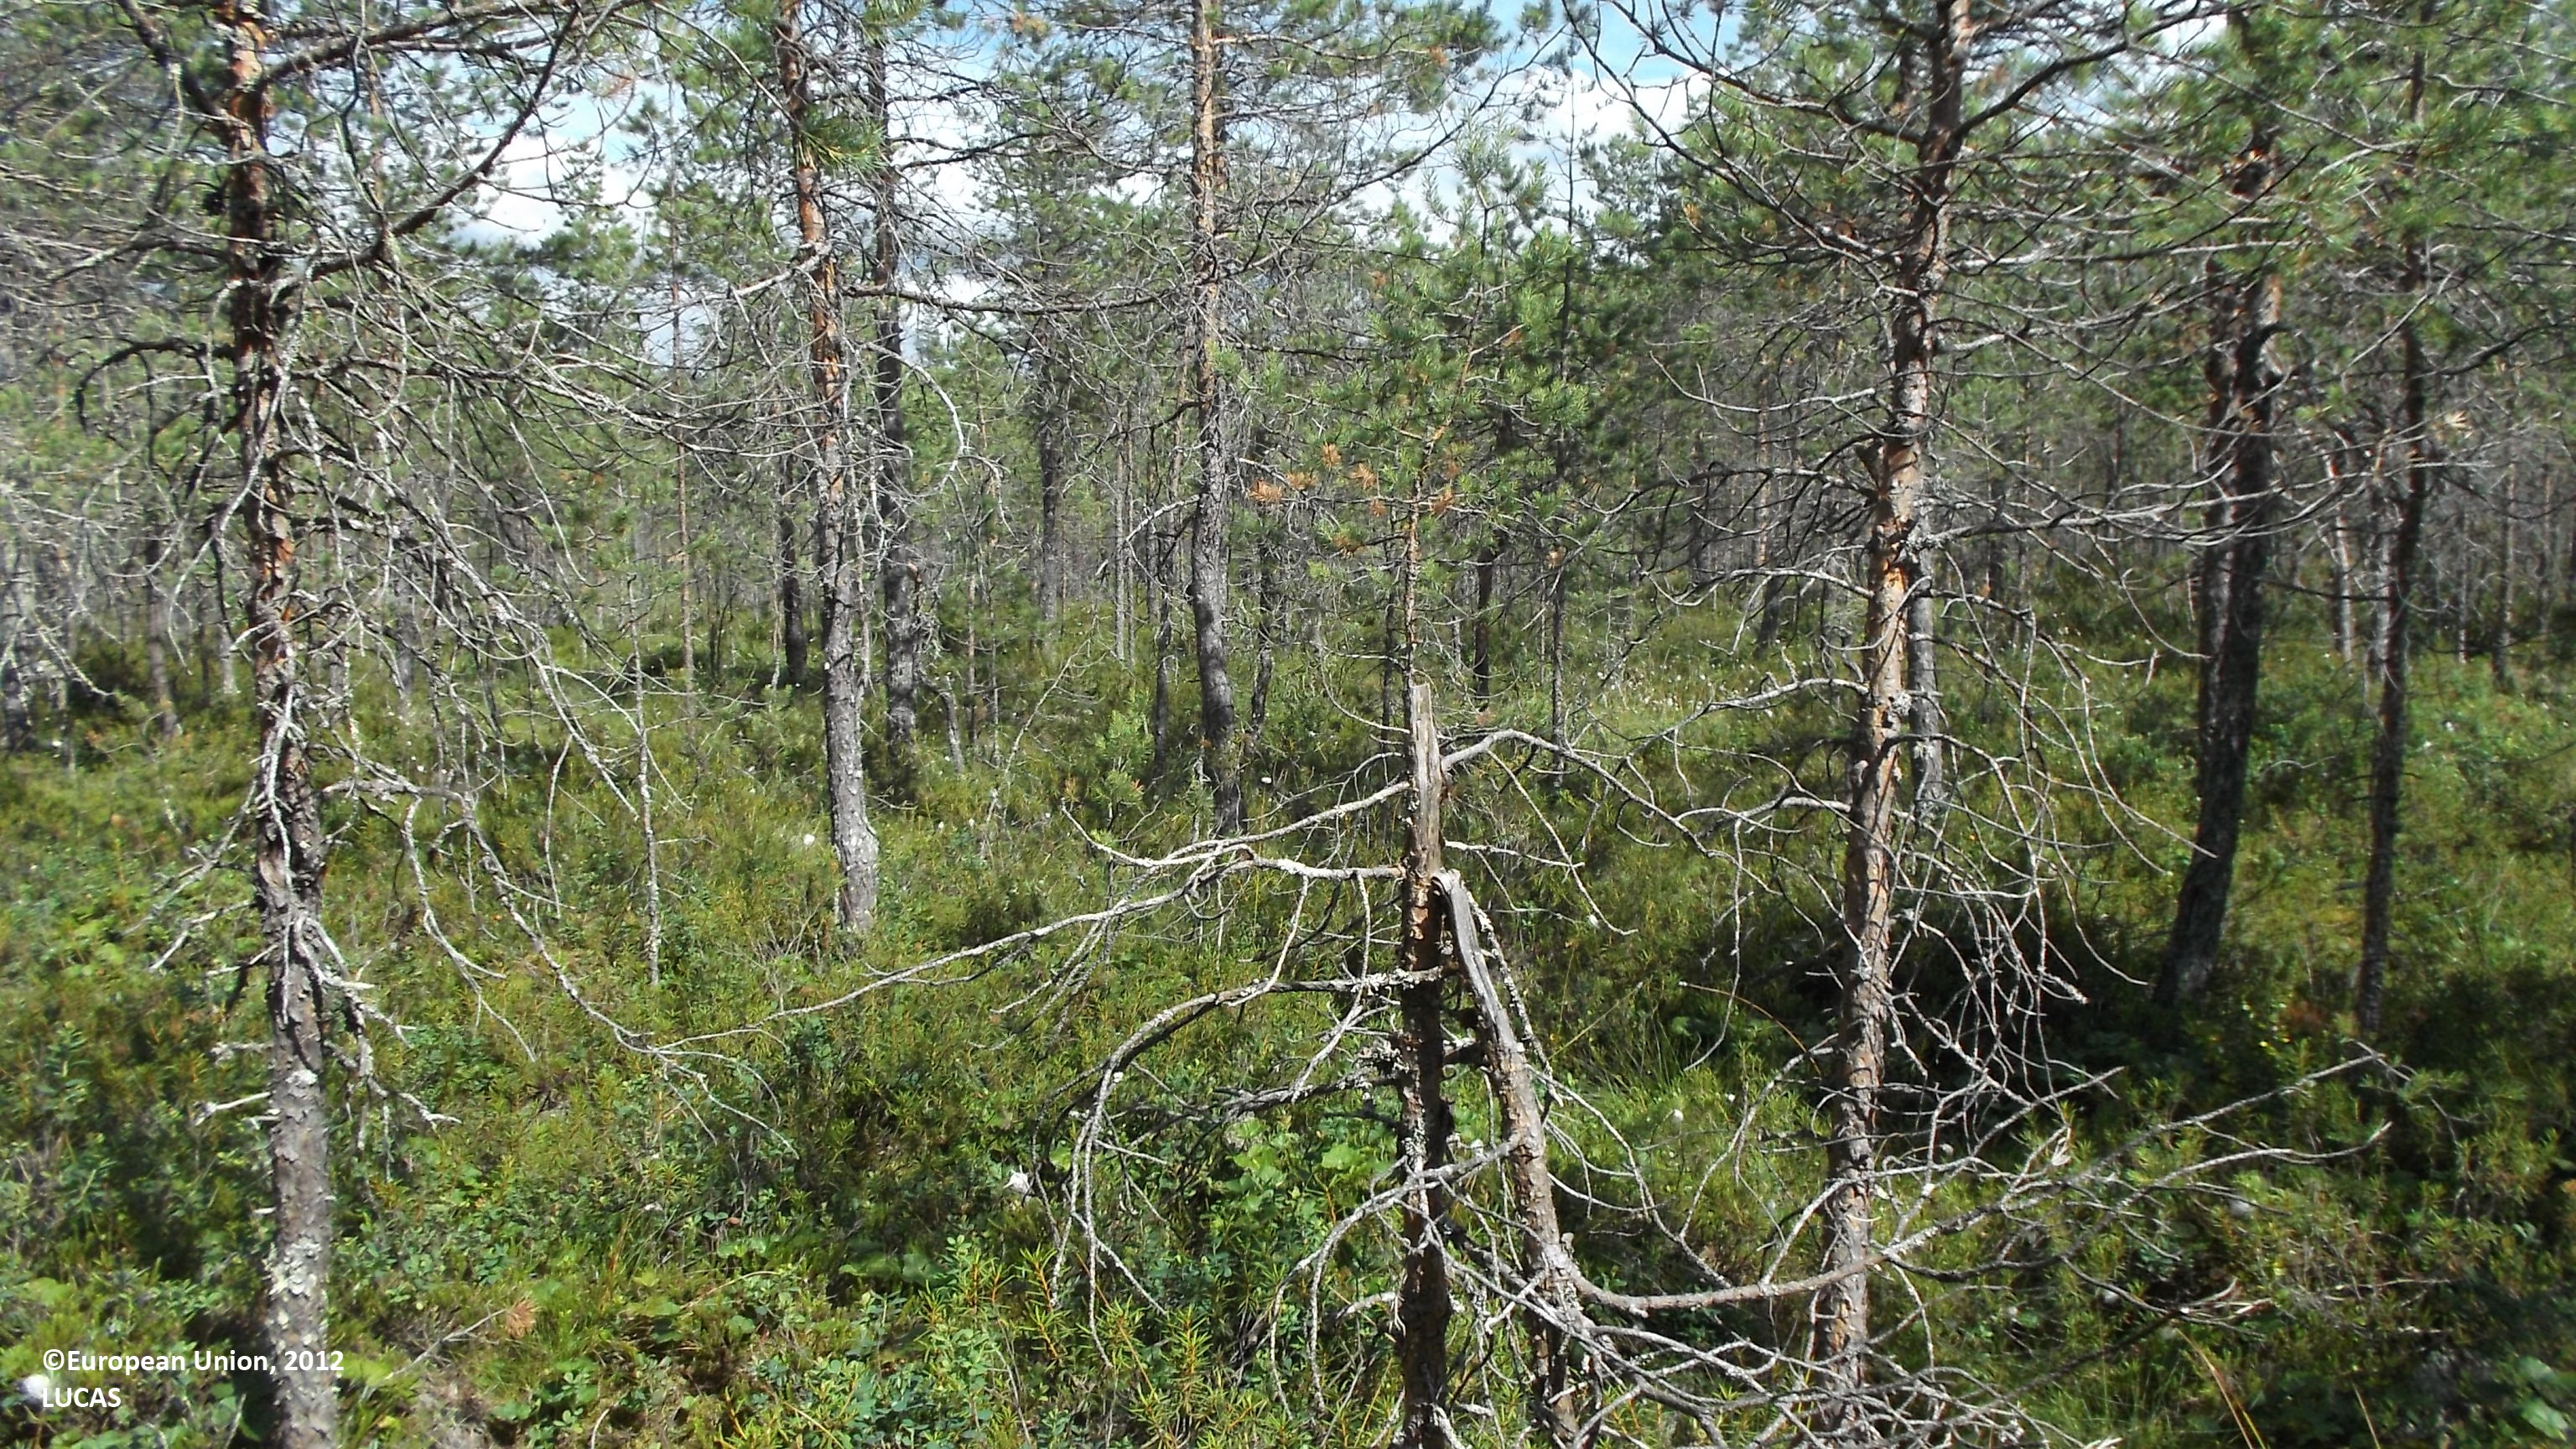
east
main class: Woodland
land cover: Pine dominated coniferous woodland
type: mire and swamp forests
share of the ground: 50 - 75 %
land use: Forestry
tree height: < 5 m
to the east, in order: Pine dominated coniferous woodland; Ditches and canals; Pine dominated coniferous woodland; Ditches and canals; Pine dominated mixed woodland; Other mixed woodland; Ditches and canals; Other mixed woodland; Ditches and canals; Other mixed woodland
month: July
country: FI
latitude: 63.2730
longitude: 23.8415
